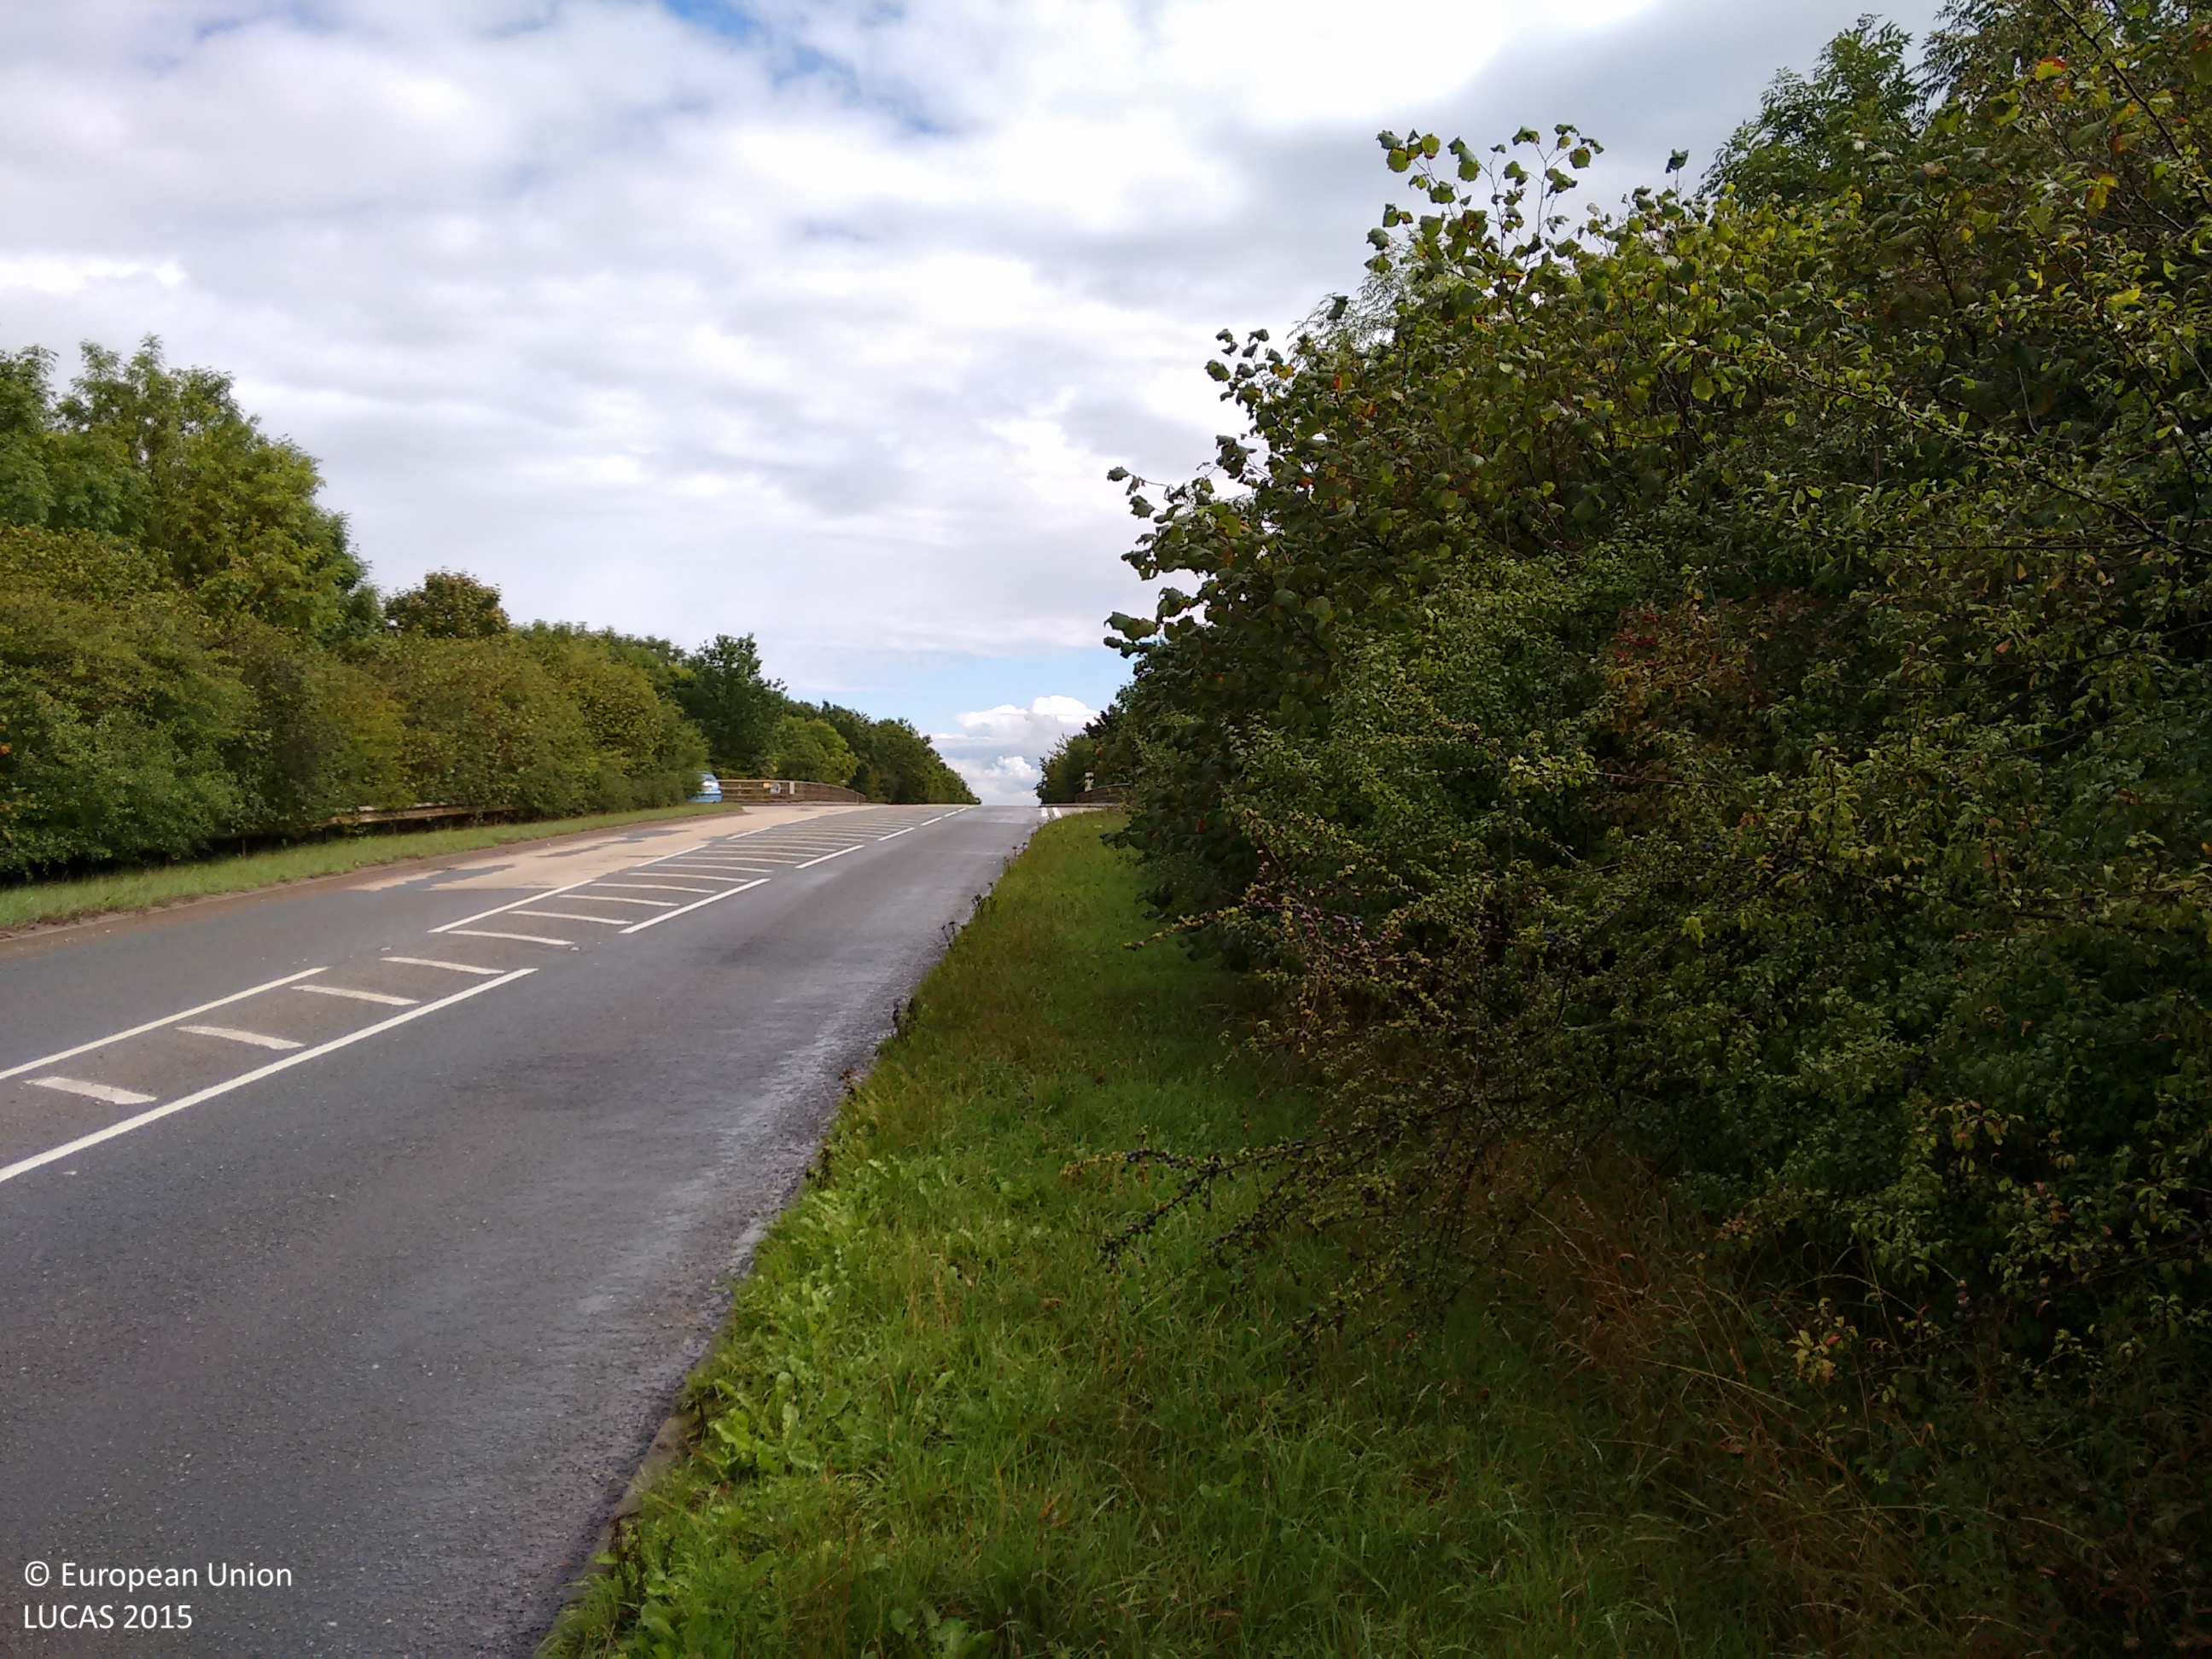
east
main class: Woodland
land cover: Broadleaved woodland
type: mesophytic deciduous forest
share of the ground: > 75 %
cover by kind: broadleaved forest trees 100 %
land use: Semi-natural and natural areas not in use
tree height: > 5 m
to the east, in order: Broadleaved woodland; Abandoned hedges; Grass margins; Artificial constructions; Grass margins; Paved roads, cycling and walking lanes; Grass margins; Artificial constructions; Grass margins; Abandoned hedges; Broadleaved woodland; Grass margins; Artificial constructions; Grass margins; Paved roads, cycling and walking lanes; Grass margins; Artificial constructions; Grass margins; Broadleaved woodland; Artificial constructions; Grass margins; Paved roads, cycling and walking lanes; Artificial constructions; Grass margins; Broadleaved woodland; Grassland without tree/shrub cover
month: September
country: GB
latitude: 53.0044
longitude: -3.0250
